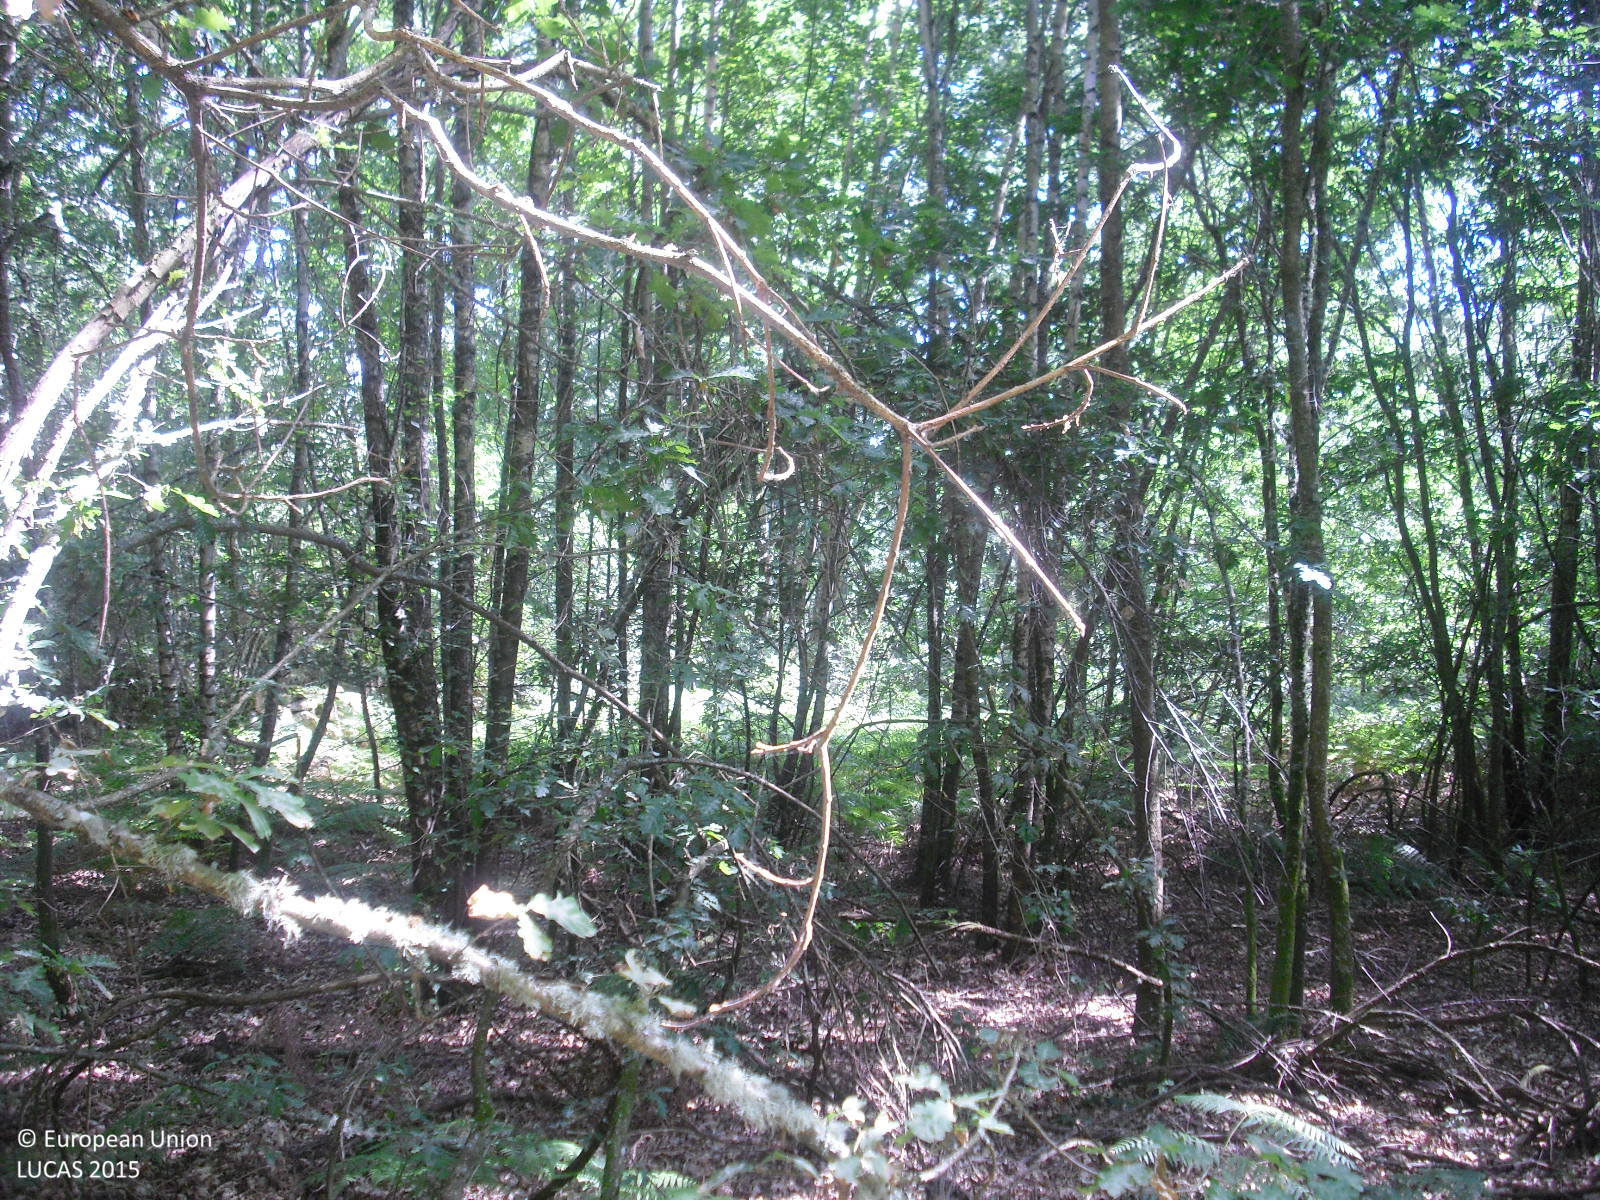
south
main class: Woodland
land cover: Broadleaved woodland
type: thermophilous deciduous forest
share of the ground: 50 - 75 %
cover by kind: broadleaved forest trees 70 %, shrubs 30 %
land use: Forestry
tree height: > 5 m
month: July
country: ES
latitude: 42.2942
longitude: -7.7199
